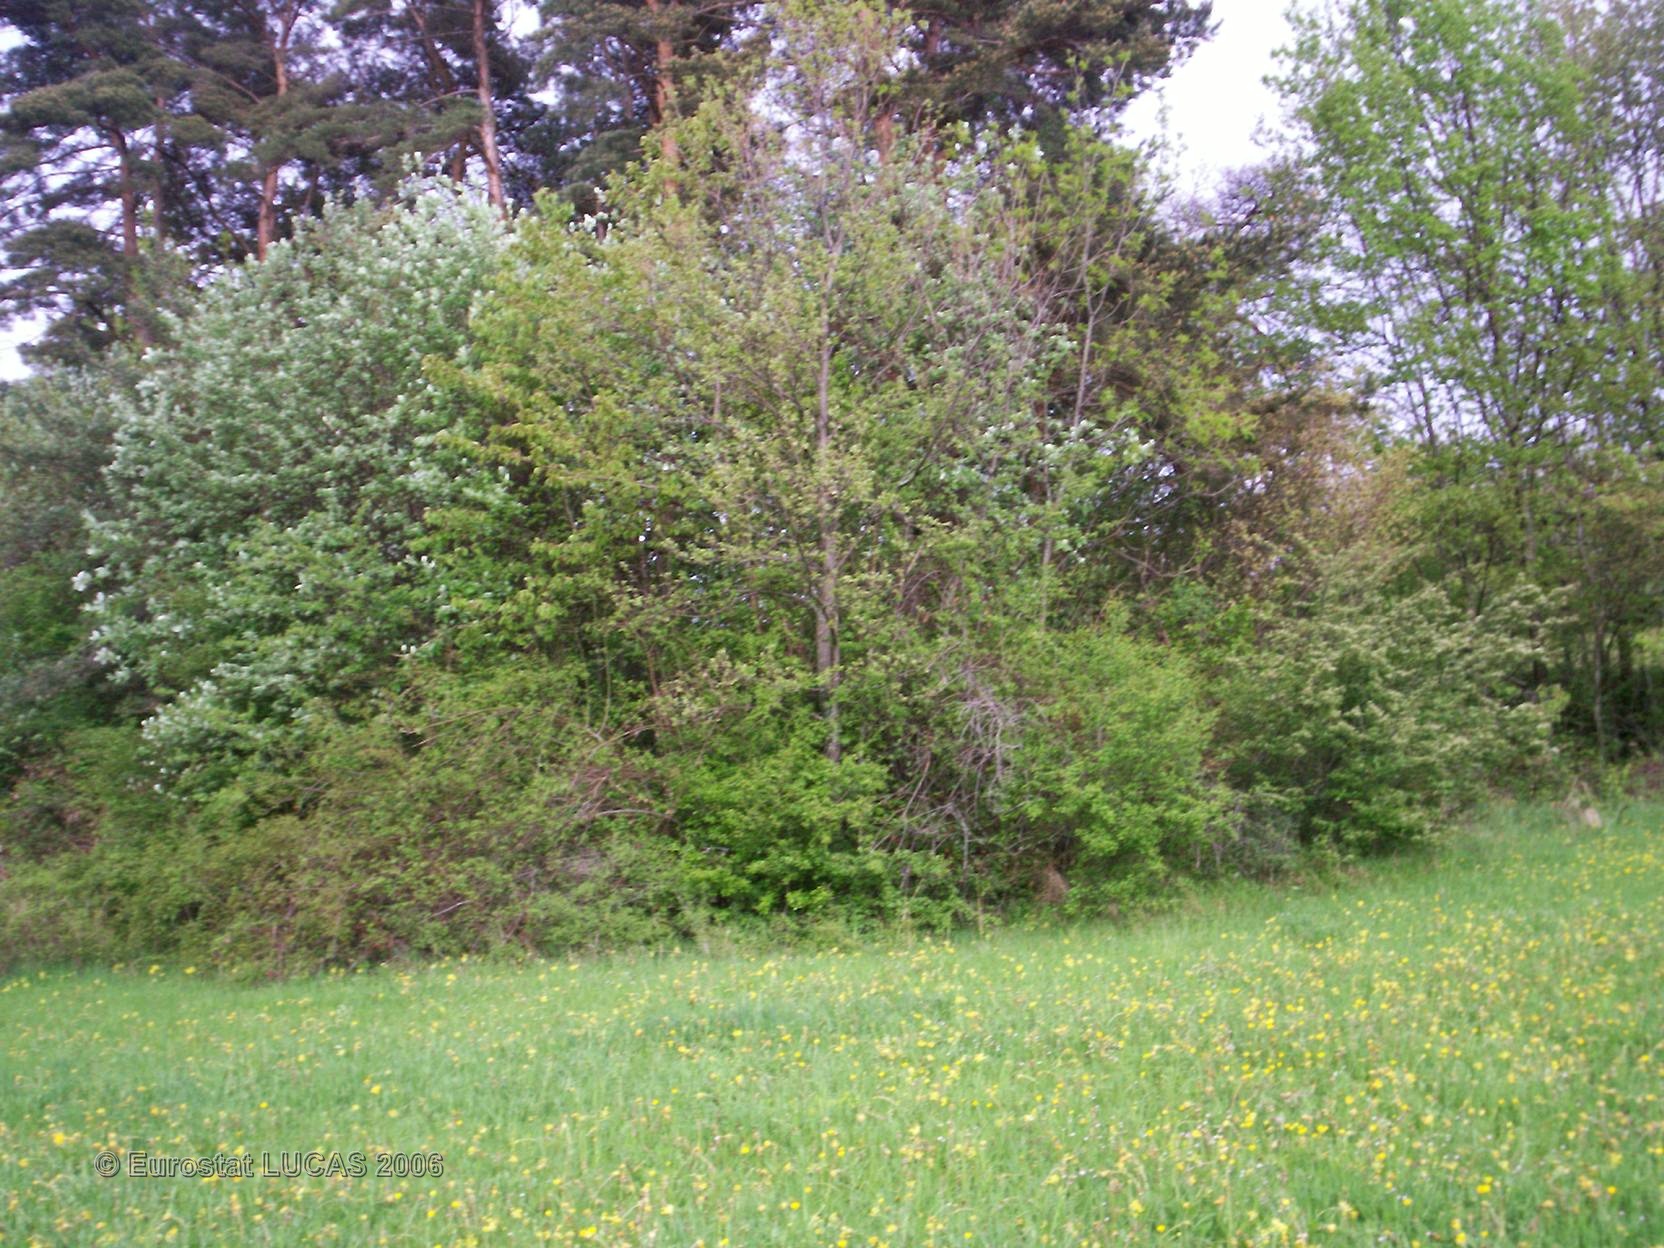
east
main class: Grassland
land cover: Grassland without tree/shrub cover
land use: Agriculture (excluding fallow land and kitchen gardens)
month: May
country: FR
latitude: 45.5299
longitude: 3.0733
